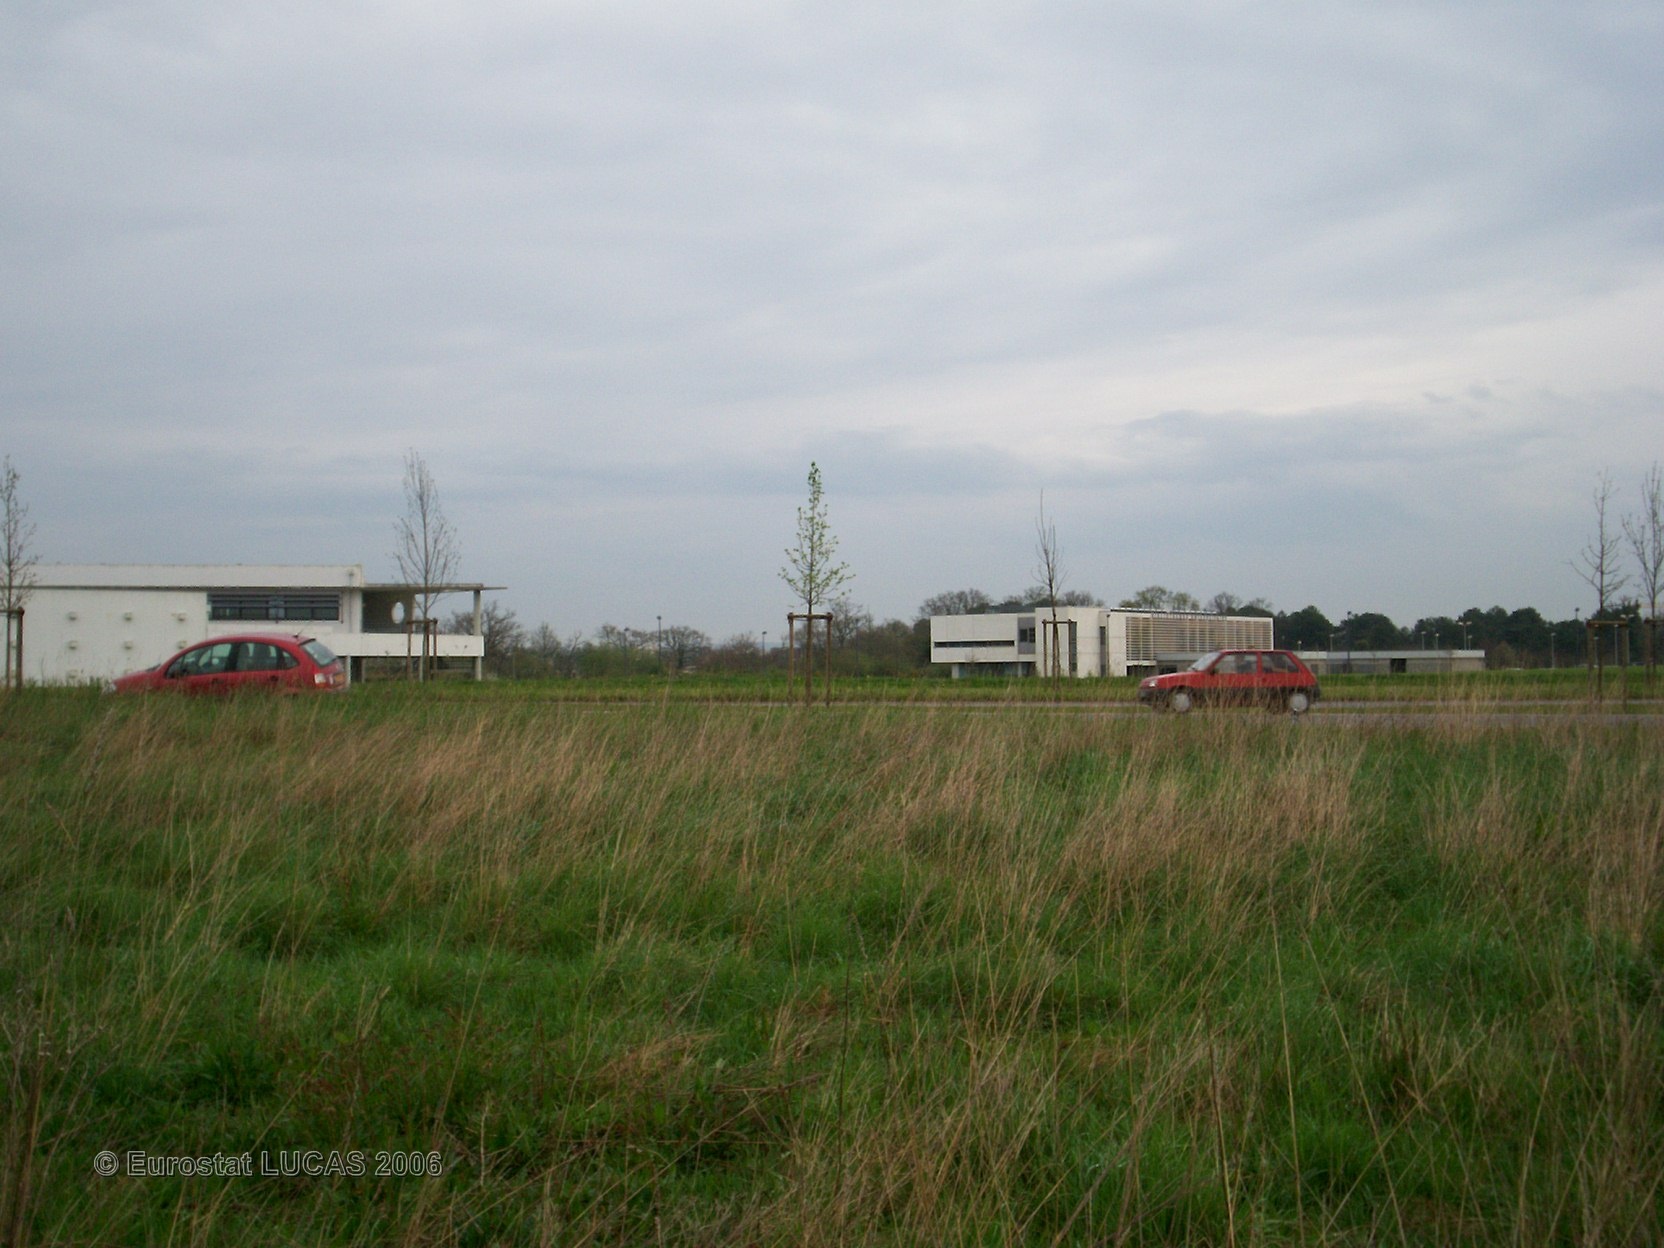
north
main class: Grassland
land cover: Grassland without tree/shrub cover
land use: Agriculture (excluding fallow land and kitchen gardens)
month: April
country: FR
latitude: 47.6438
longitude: -2.7475
